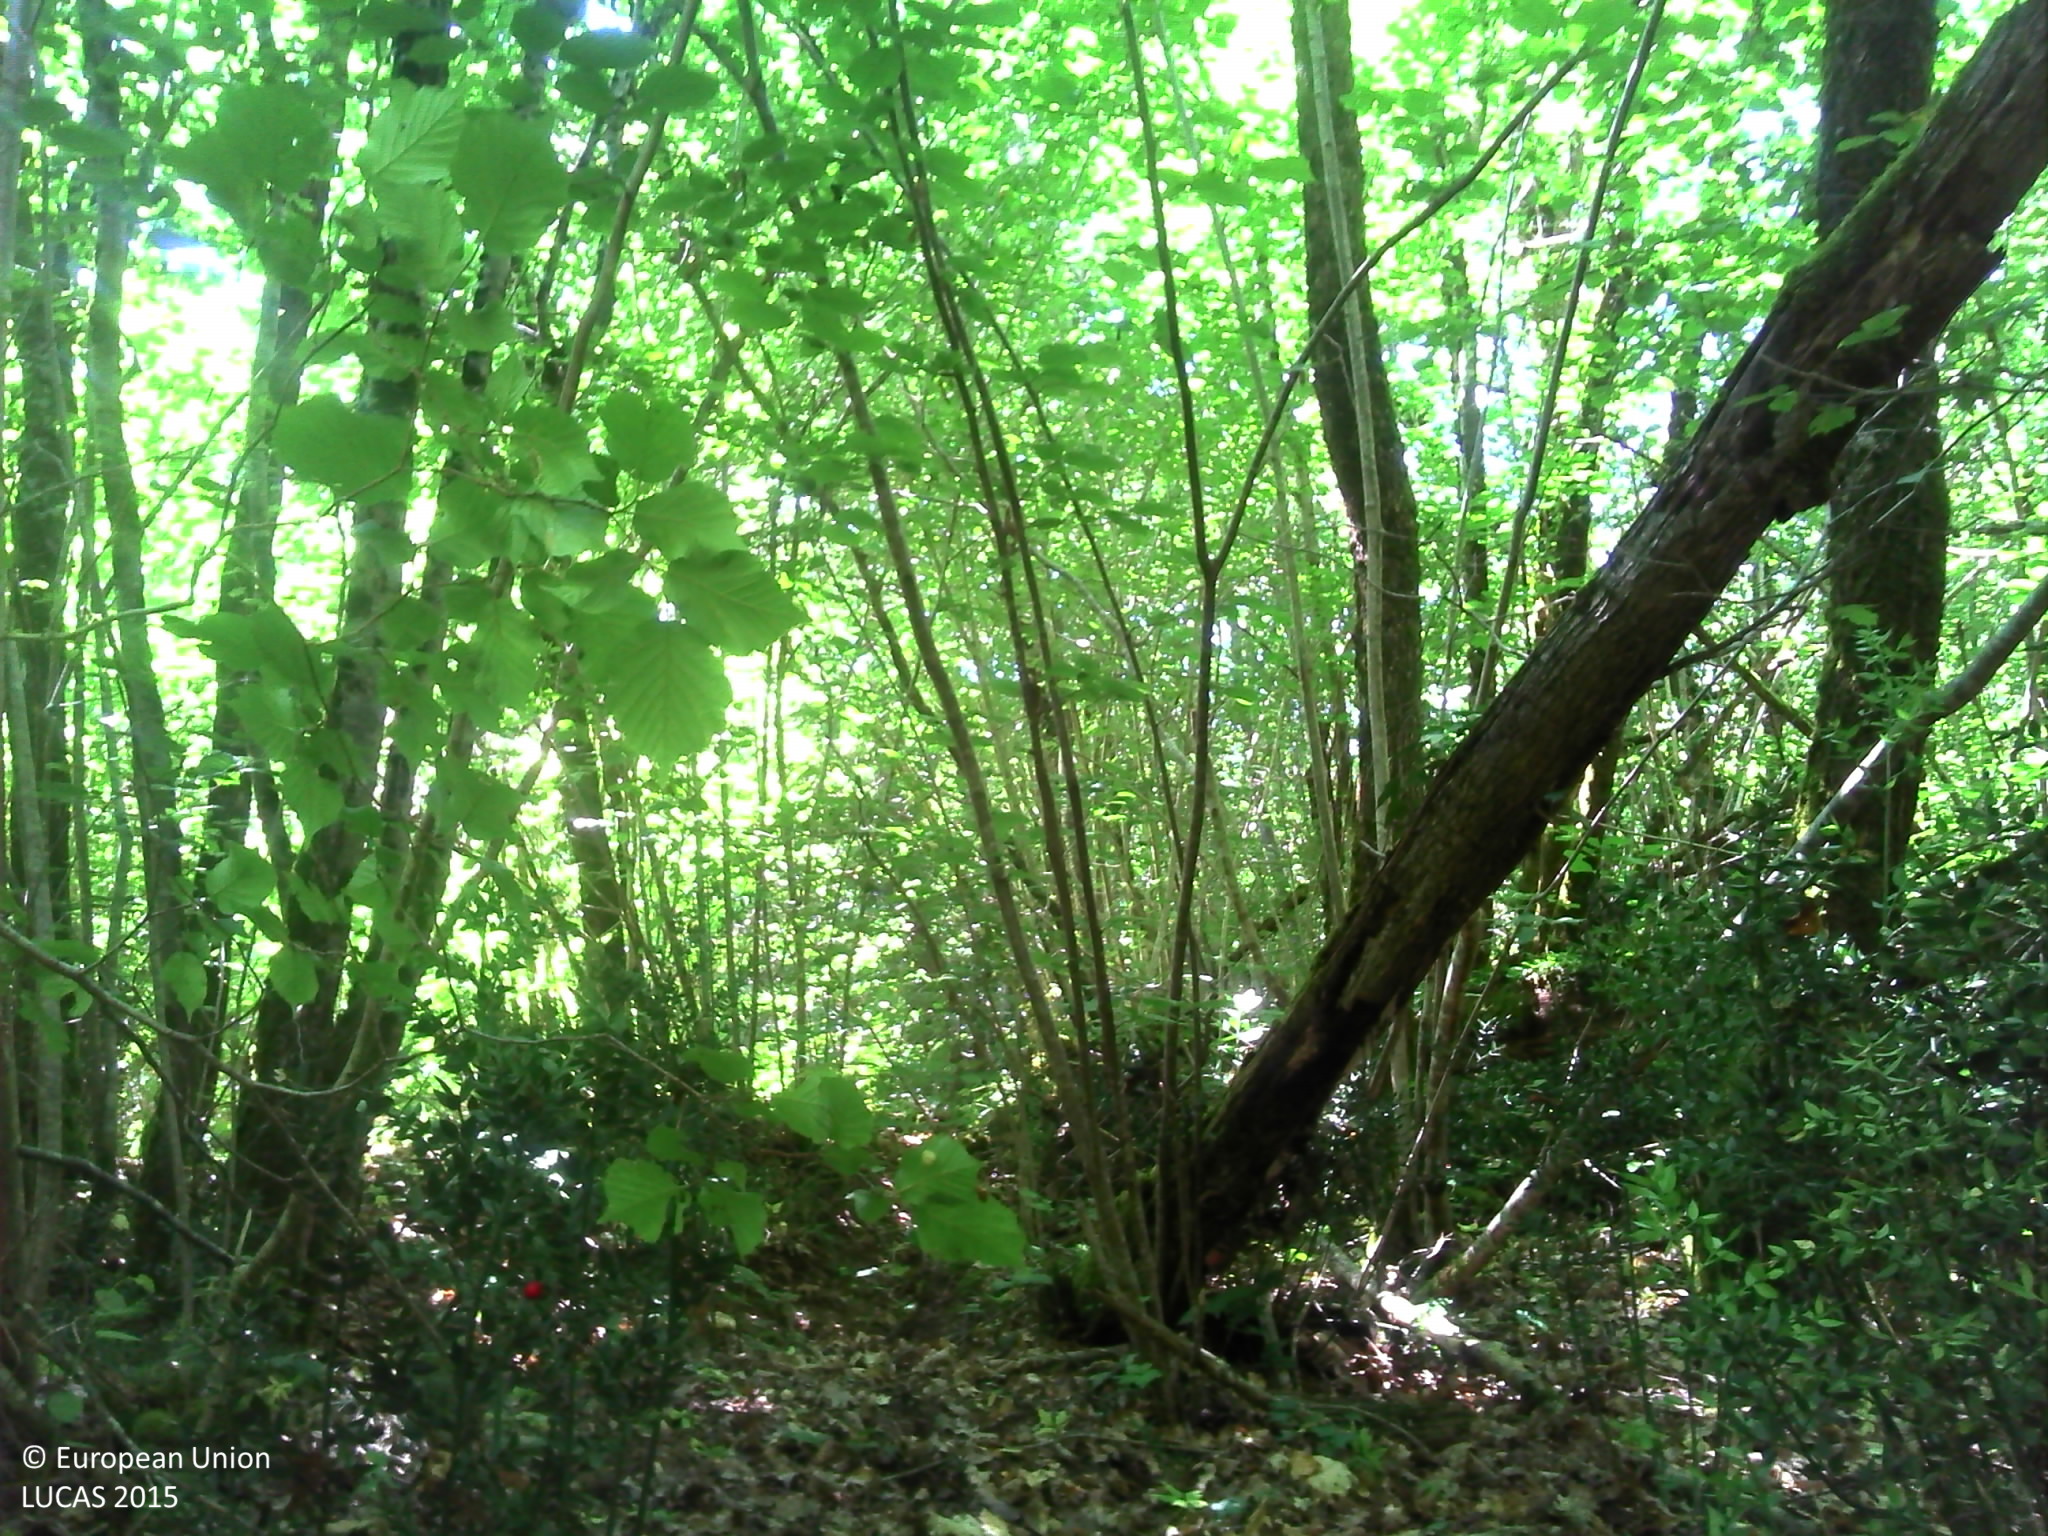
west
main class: Woodland
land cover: Broadleaved woodland
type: mesophytic deciduous forest
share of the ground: > 75 %
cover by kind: broadleaved forest trees 100 %
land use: Forestry
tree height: > 5 m
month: June
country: FR
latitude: 45.6558
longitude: -0.6367
